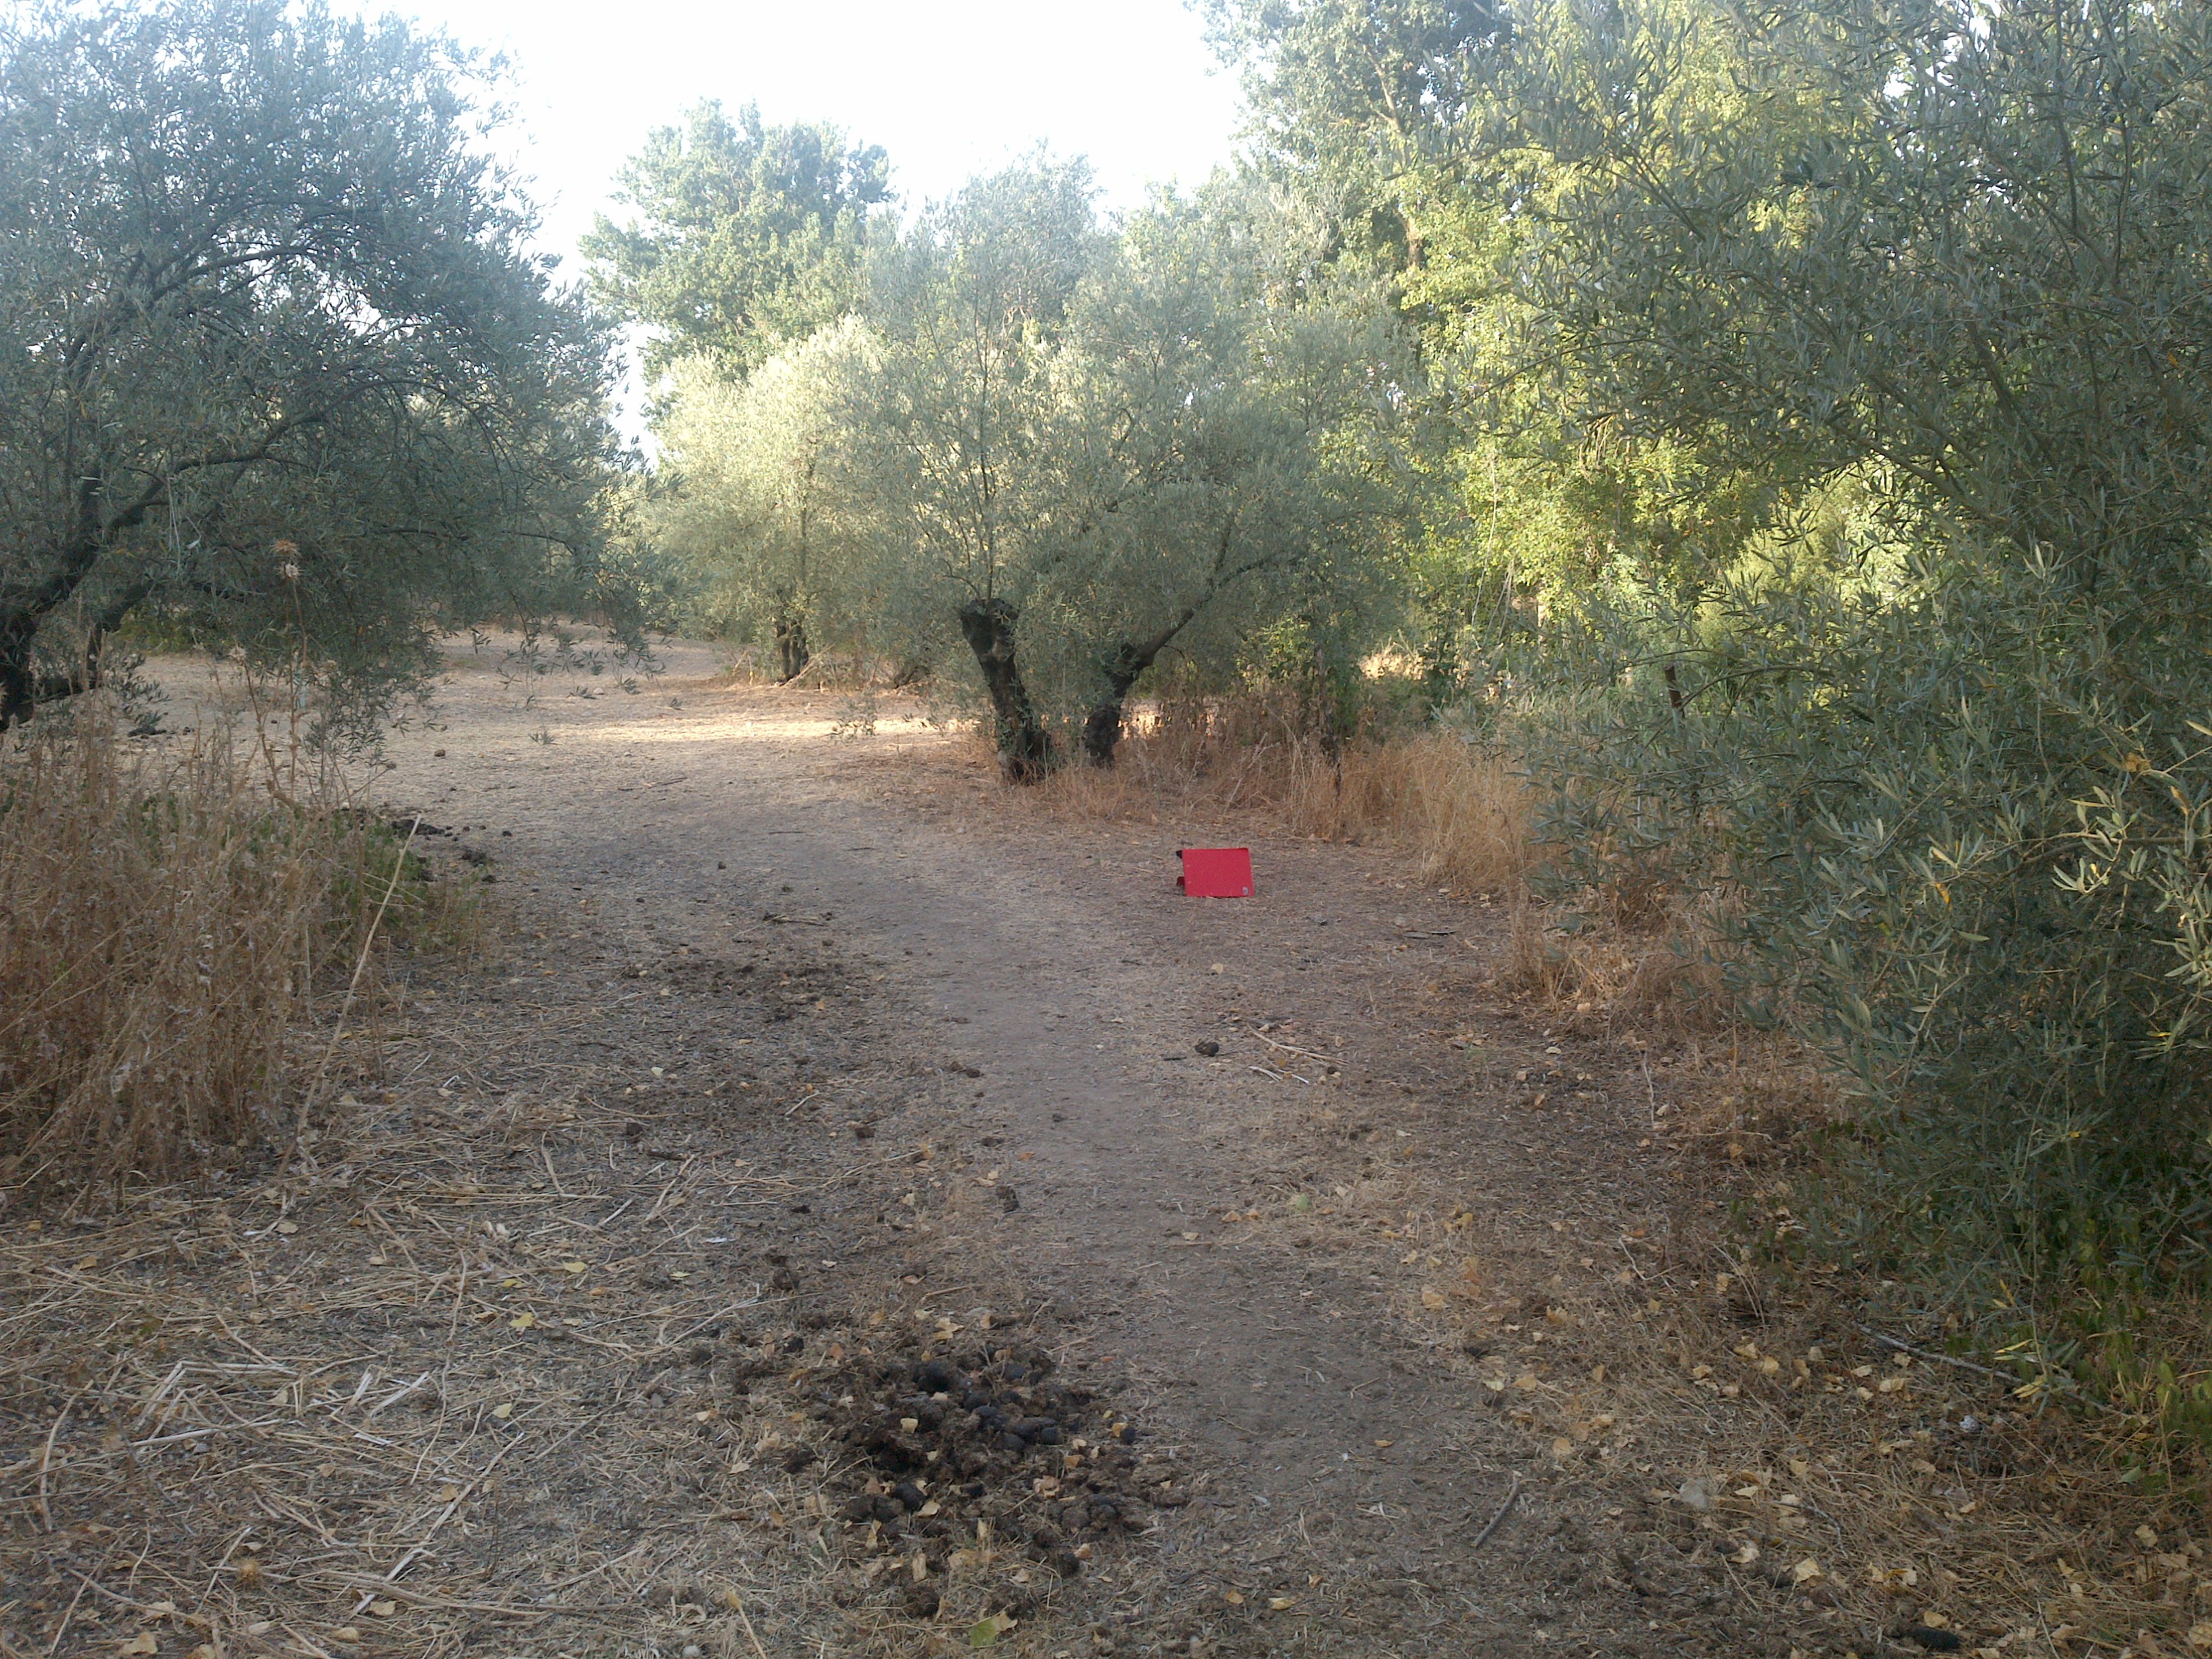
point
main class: Cropland
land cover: Olive groves
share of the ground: 50 - 75 %
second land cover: Spontaneously vegetated surfaces
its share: 10 - 25 %
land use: Agriculture (excluding fallow land and kitchen gardens)
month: July
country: ES
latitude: 37.3739
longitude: -4.4447
